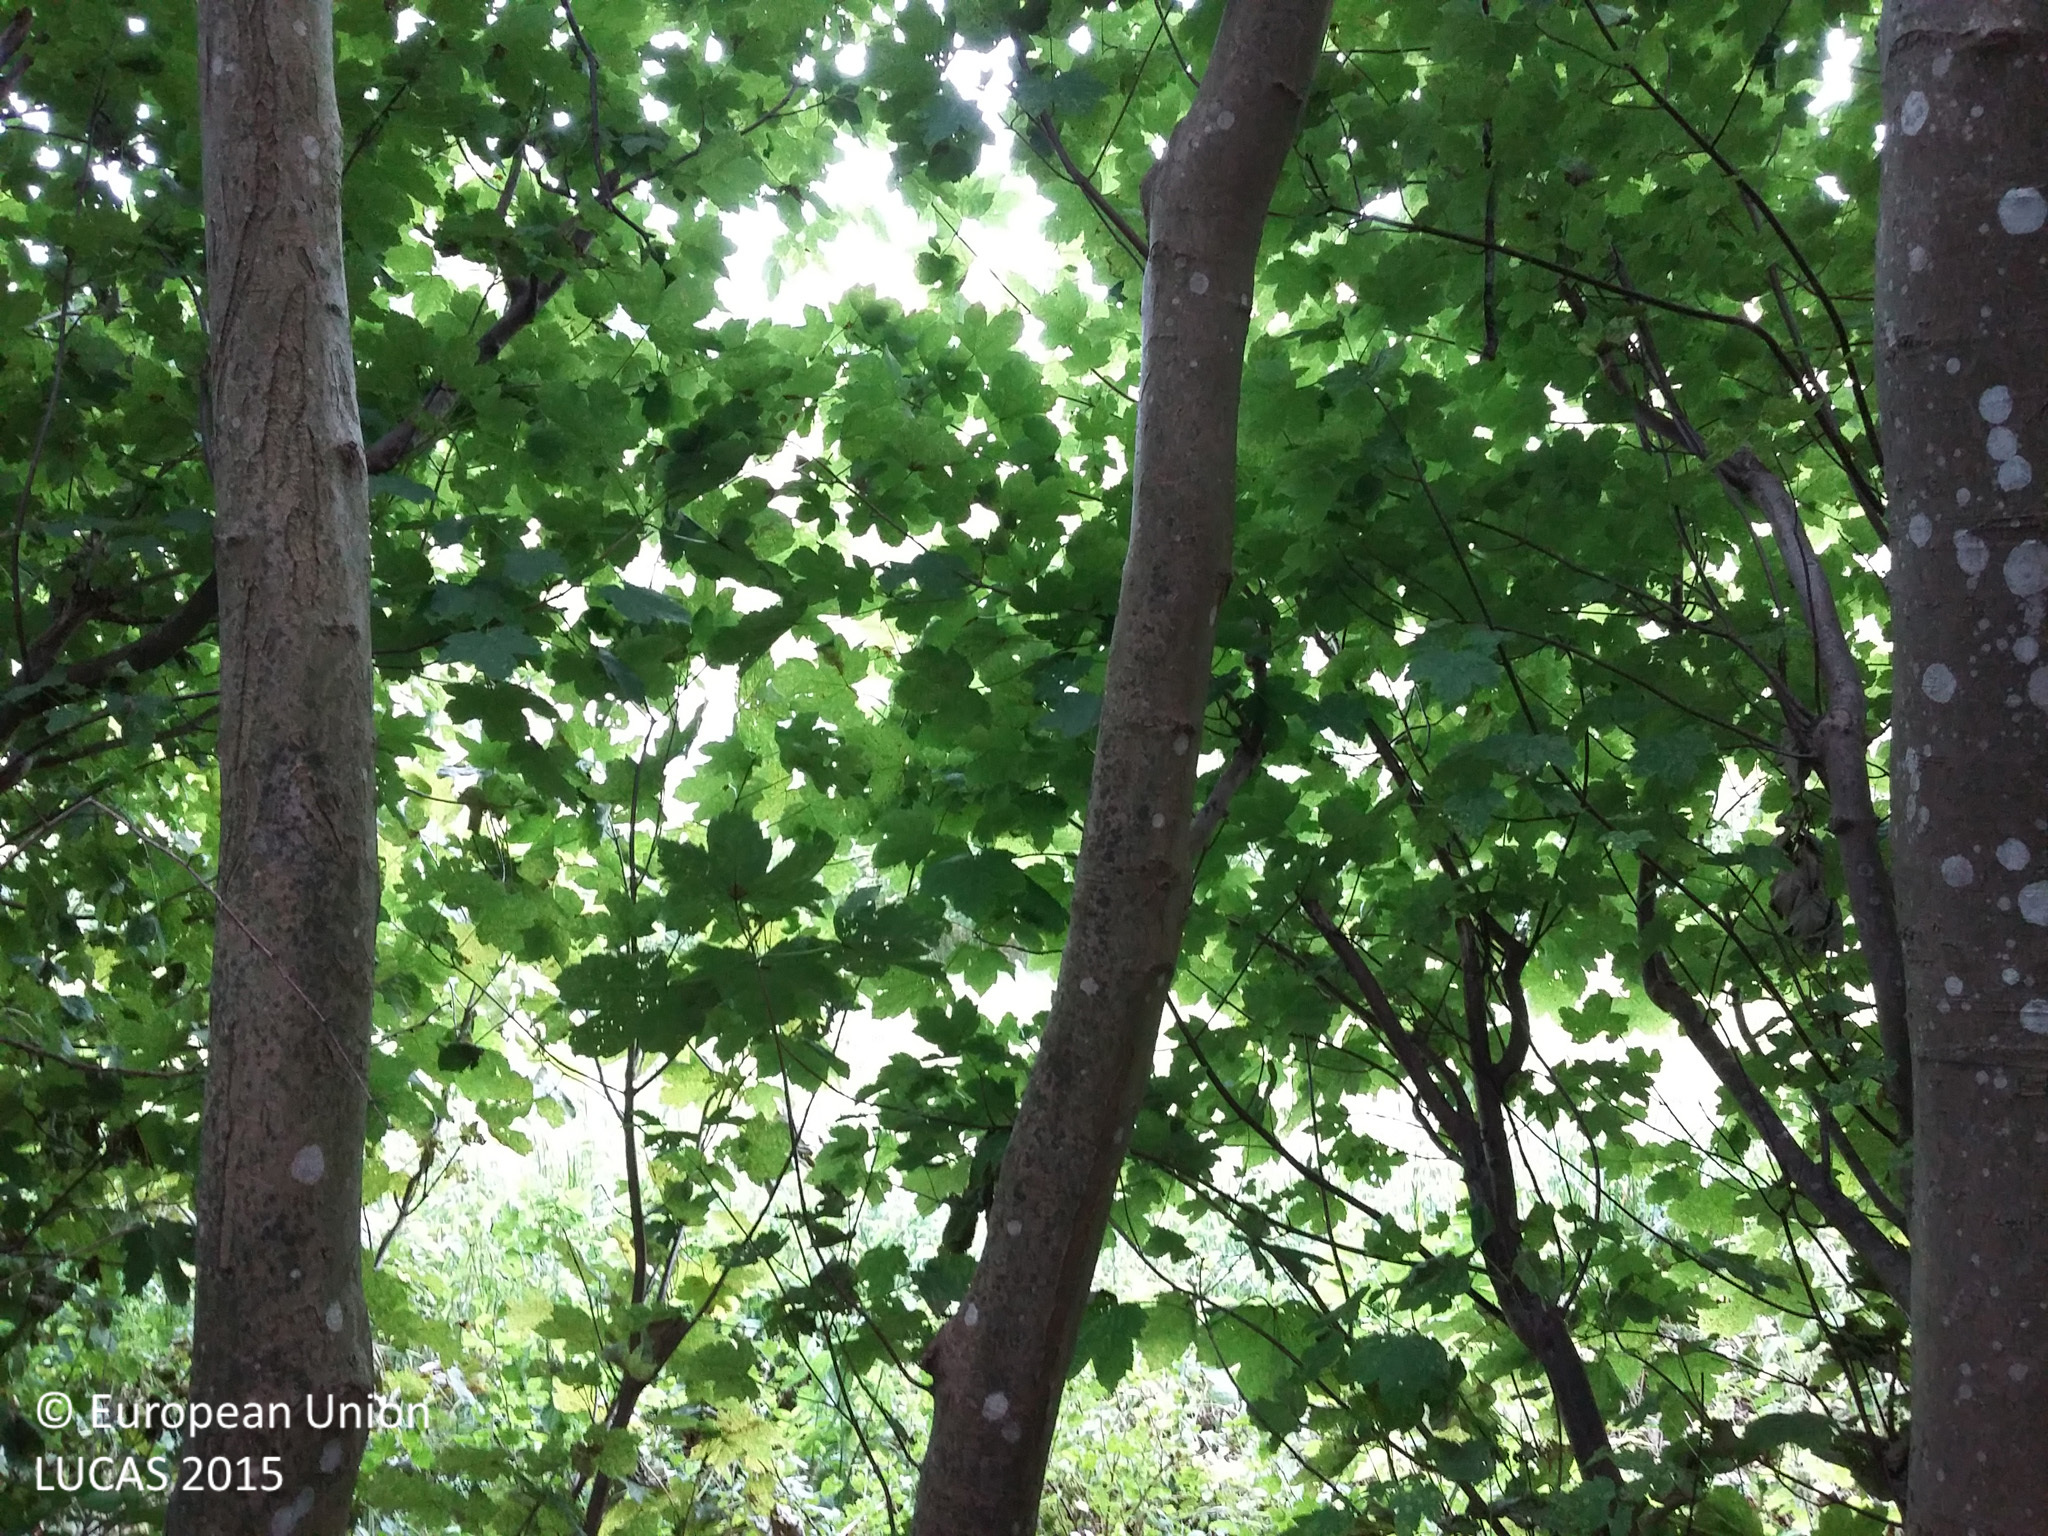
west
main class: Woodland
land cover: Broadleaved woodland
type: beech forest
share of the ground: > 75 %
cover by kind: broadleaved forest trees 90 %, herbaceous plants 5 %, unconsolidated bare surface 5 %
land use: Forestry
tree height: > 5 m
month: August
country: DK
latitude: 55.5101
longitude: 11.7878
